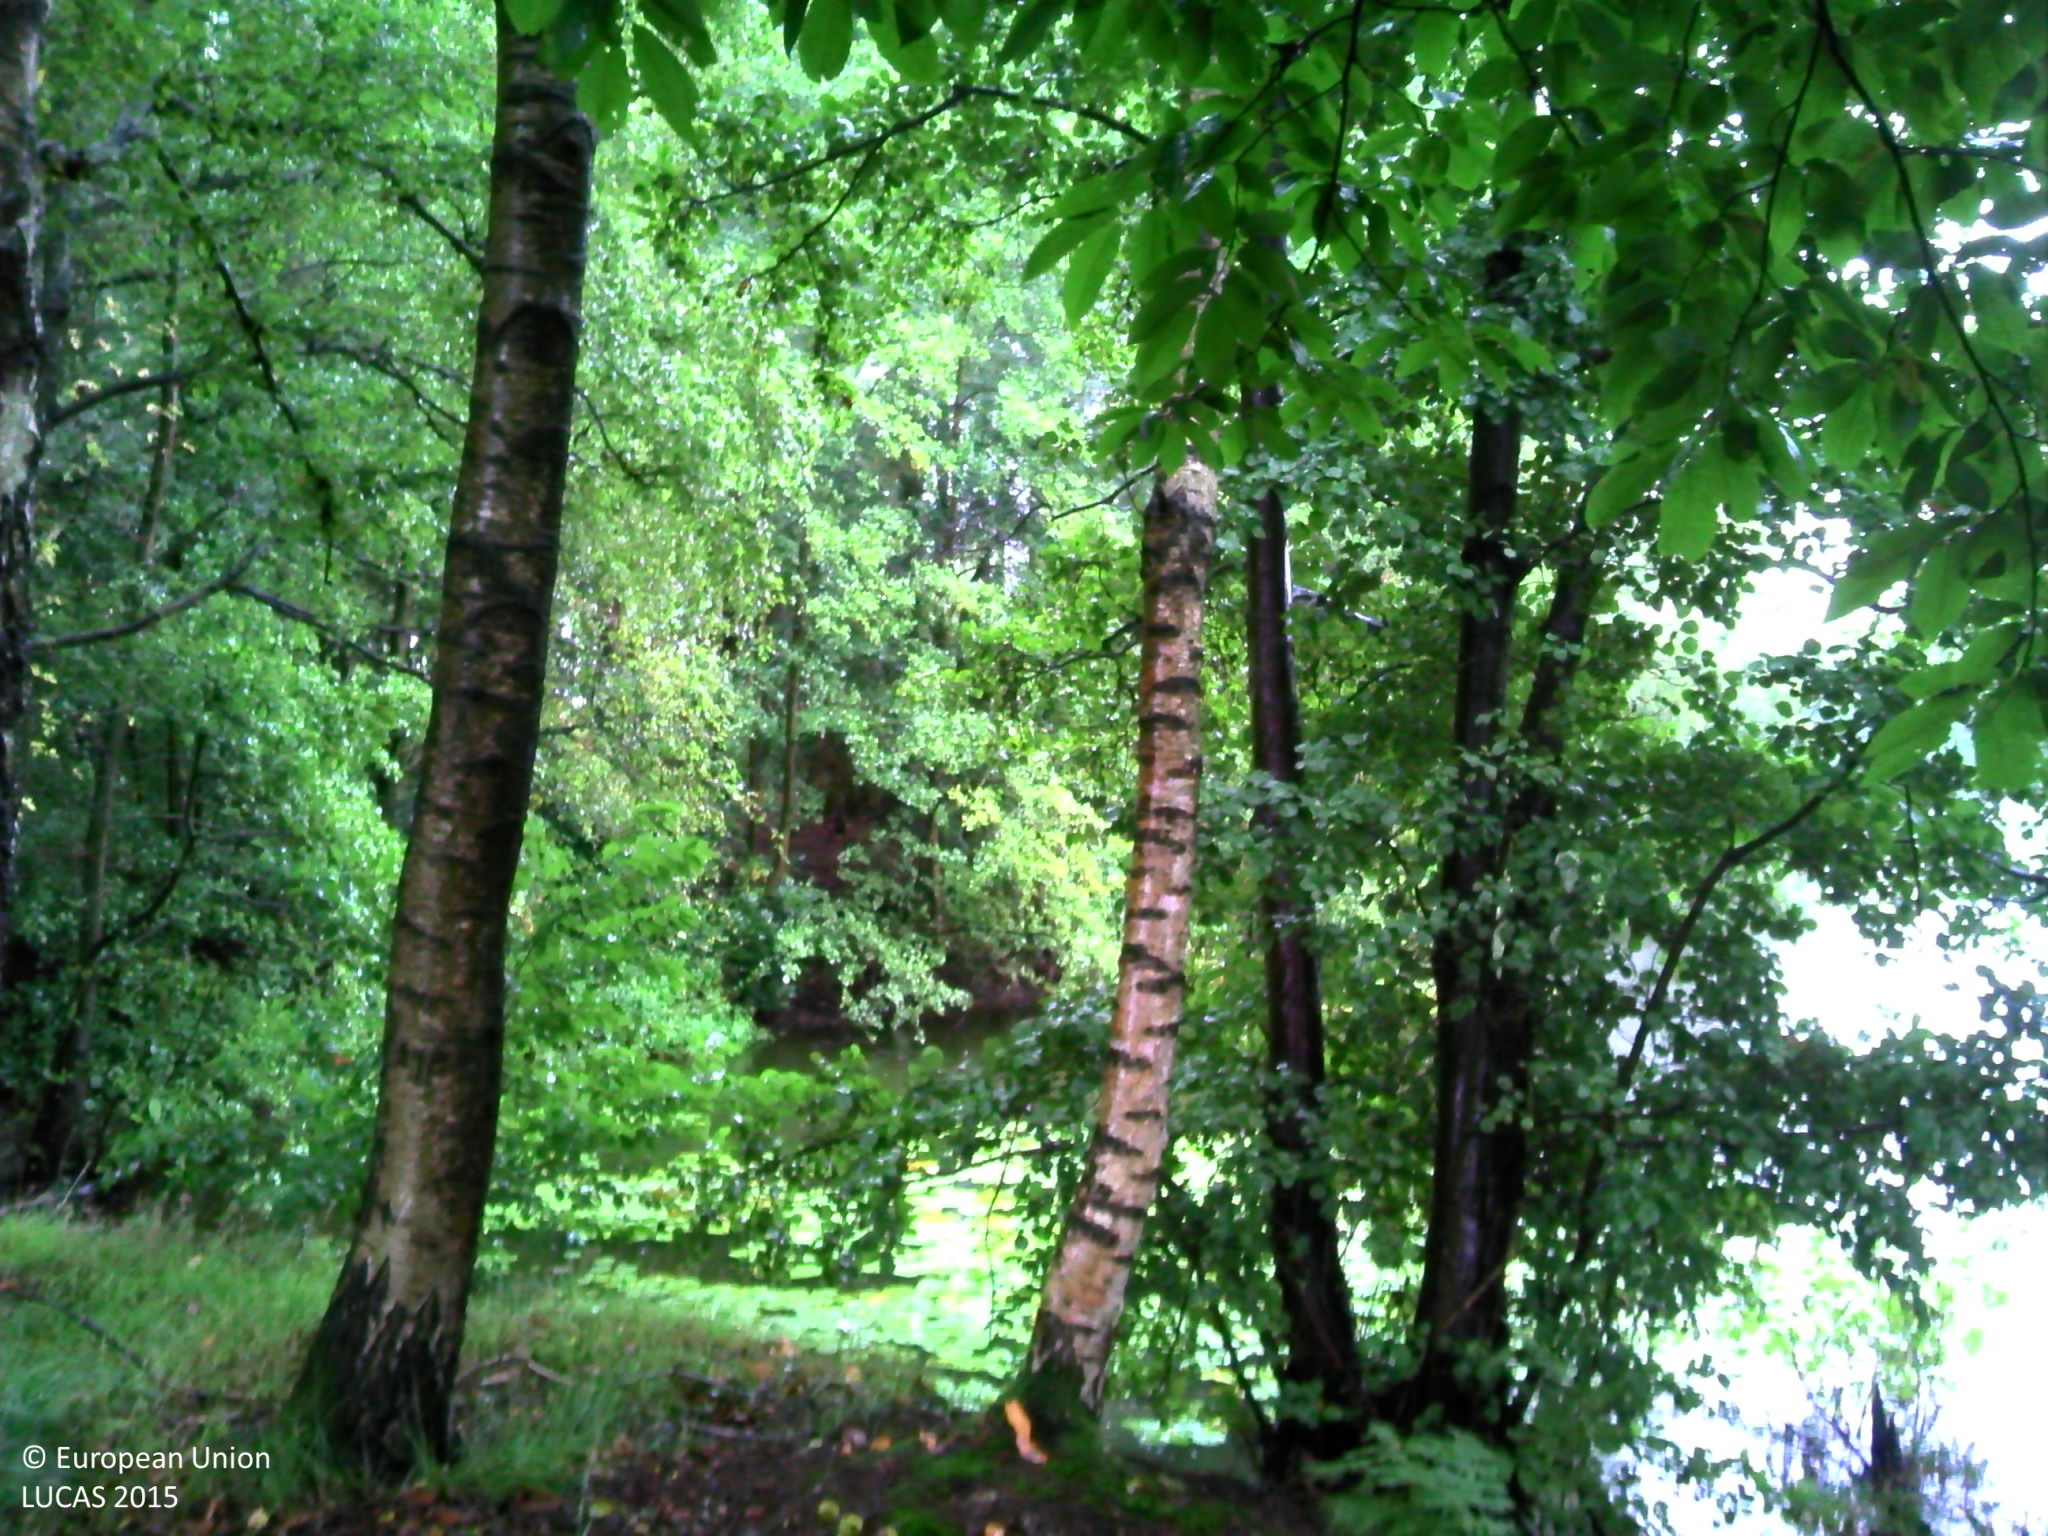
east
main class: Woodland
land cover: Broadleaved woodland
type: floodplain forest
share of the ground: > 75 %
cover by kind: broadleaved forest trees 80 %, herbaceous plants 20 %
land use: Forestry
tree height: > 5 m
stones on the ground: < 10 %
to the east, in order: Broadleaved woodland; Pine dominated coniferous woodland; Tracks; Broadleaved woodland; Fences; Ditches and canals; Grass margins; Maize
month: September
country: BE
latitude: 51.3416
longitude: 4.7279
